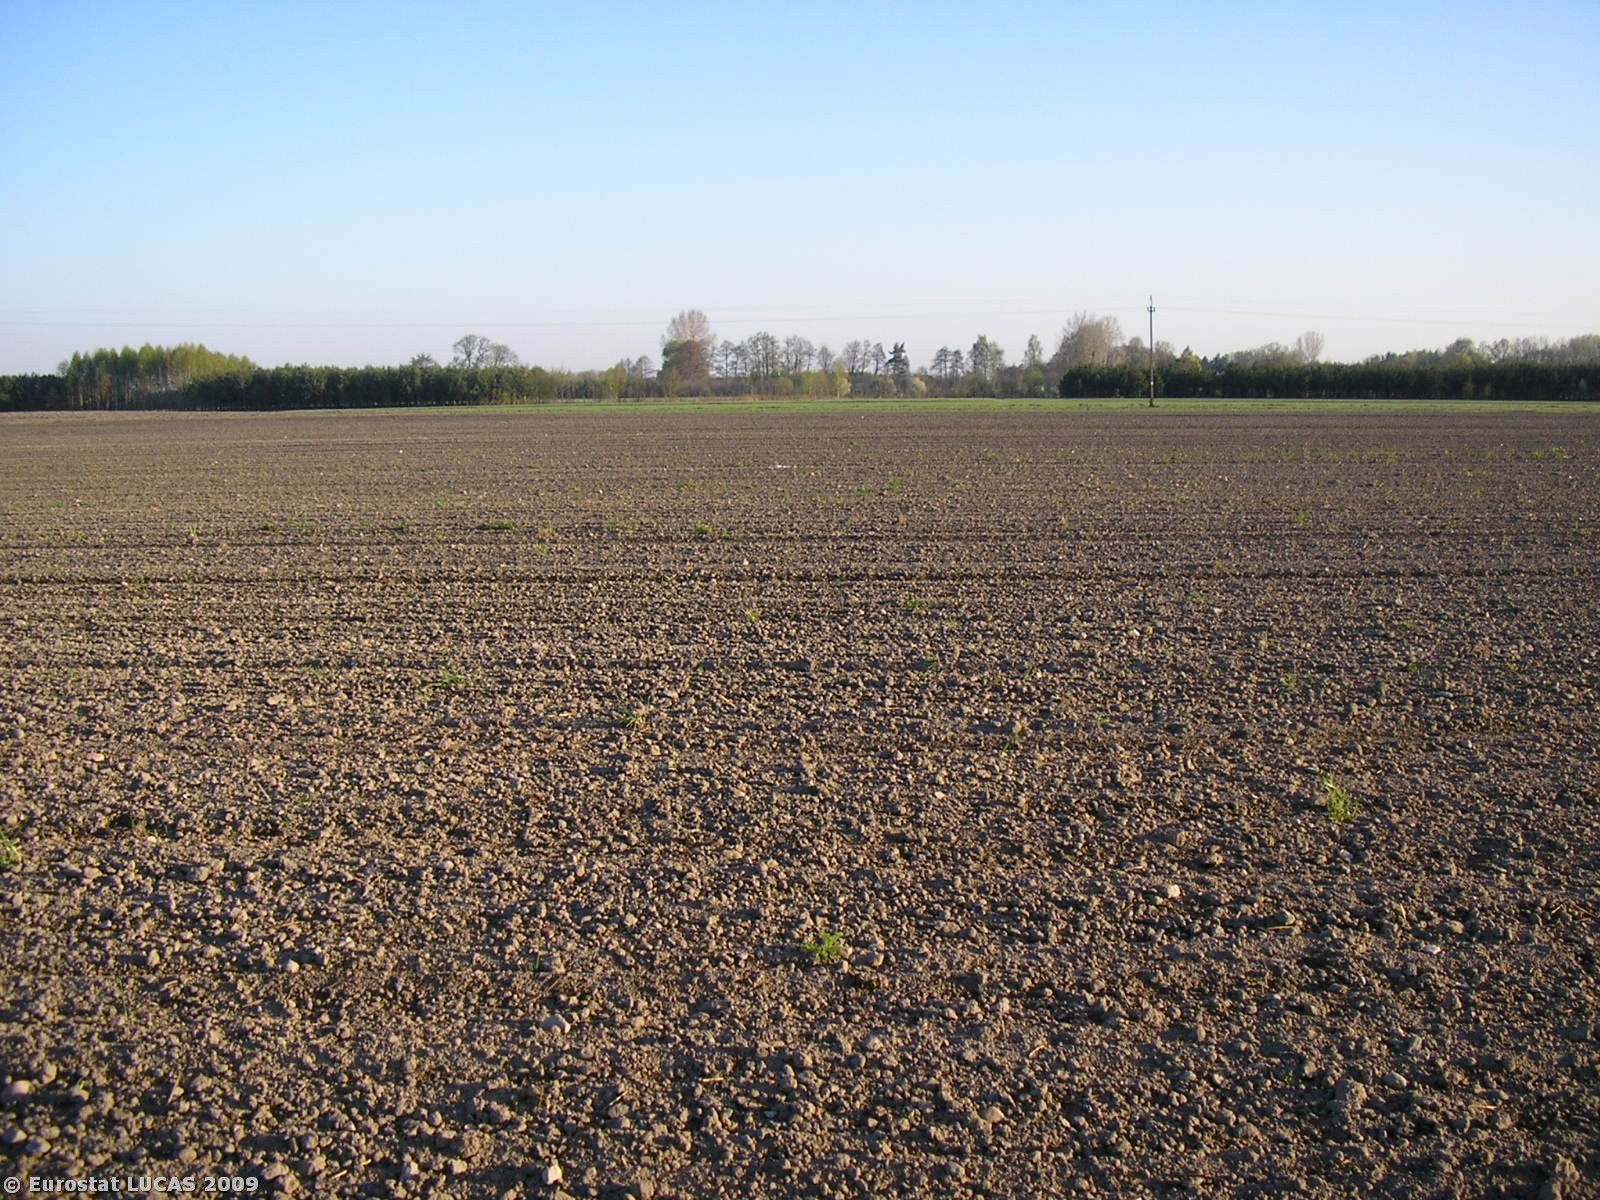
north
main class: Cropland
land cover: Other root crops
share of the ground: < 10 %
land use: Agriculture (excluding fallow land and kitchen gardens)
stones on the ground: < 10 %
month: April
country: PL
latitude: 52.0737
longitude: 20.0860
